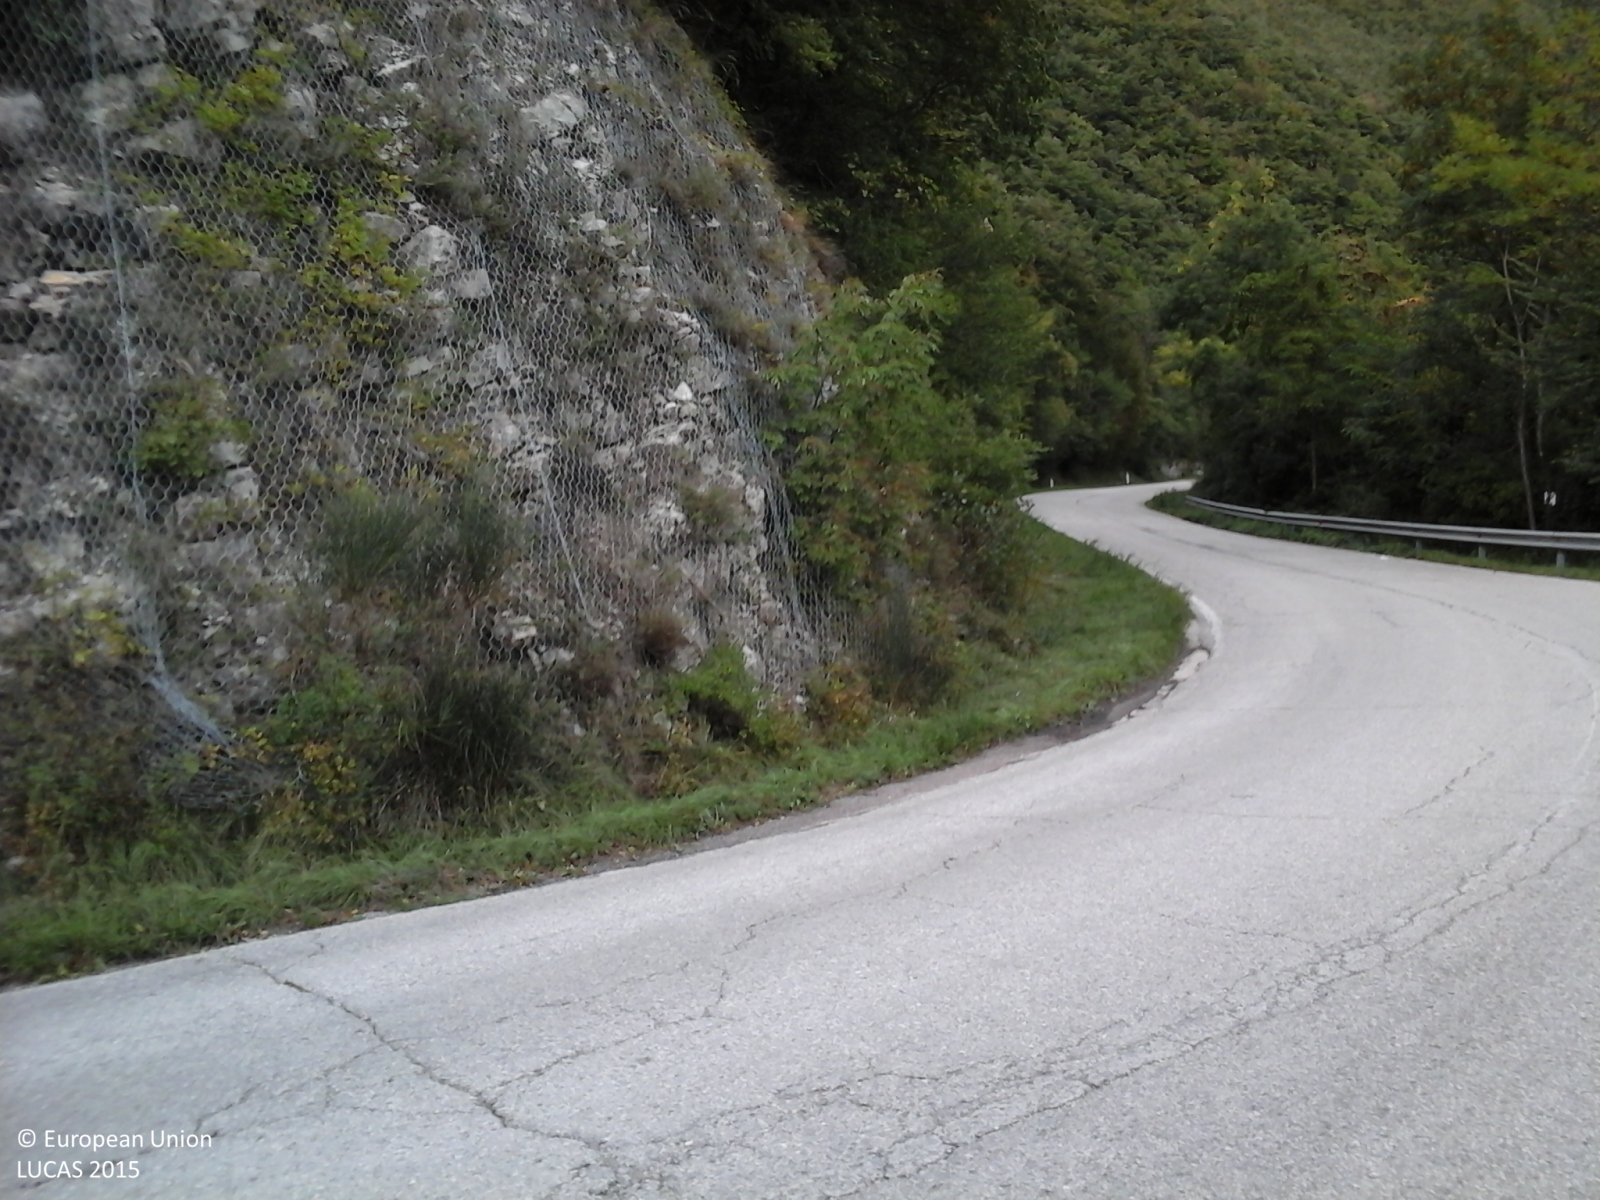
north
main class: Woodland
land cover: Broadleaved woodland
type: thermophilous deciduous forest
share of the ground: > 75 %
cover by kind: broadleaved forest trees 100 %
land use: Forestry
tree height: > 5 m
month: October
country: IT
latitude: 43.5243
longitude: 12.5791
